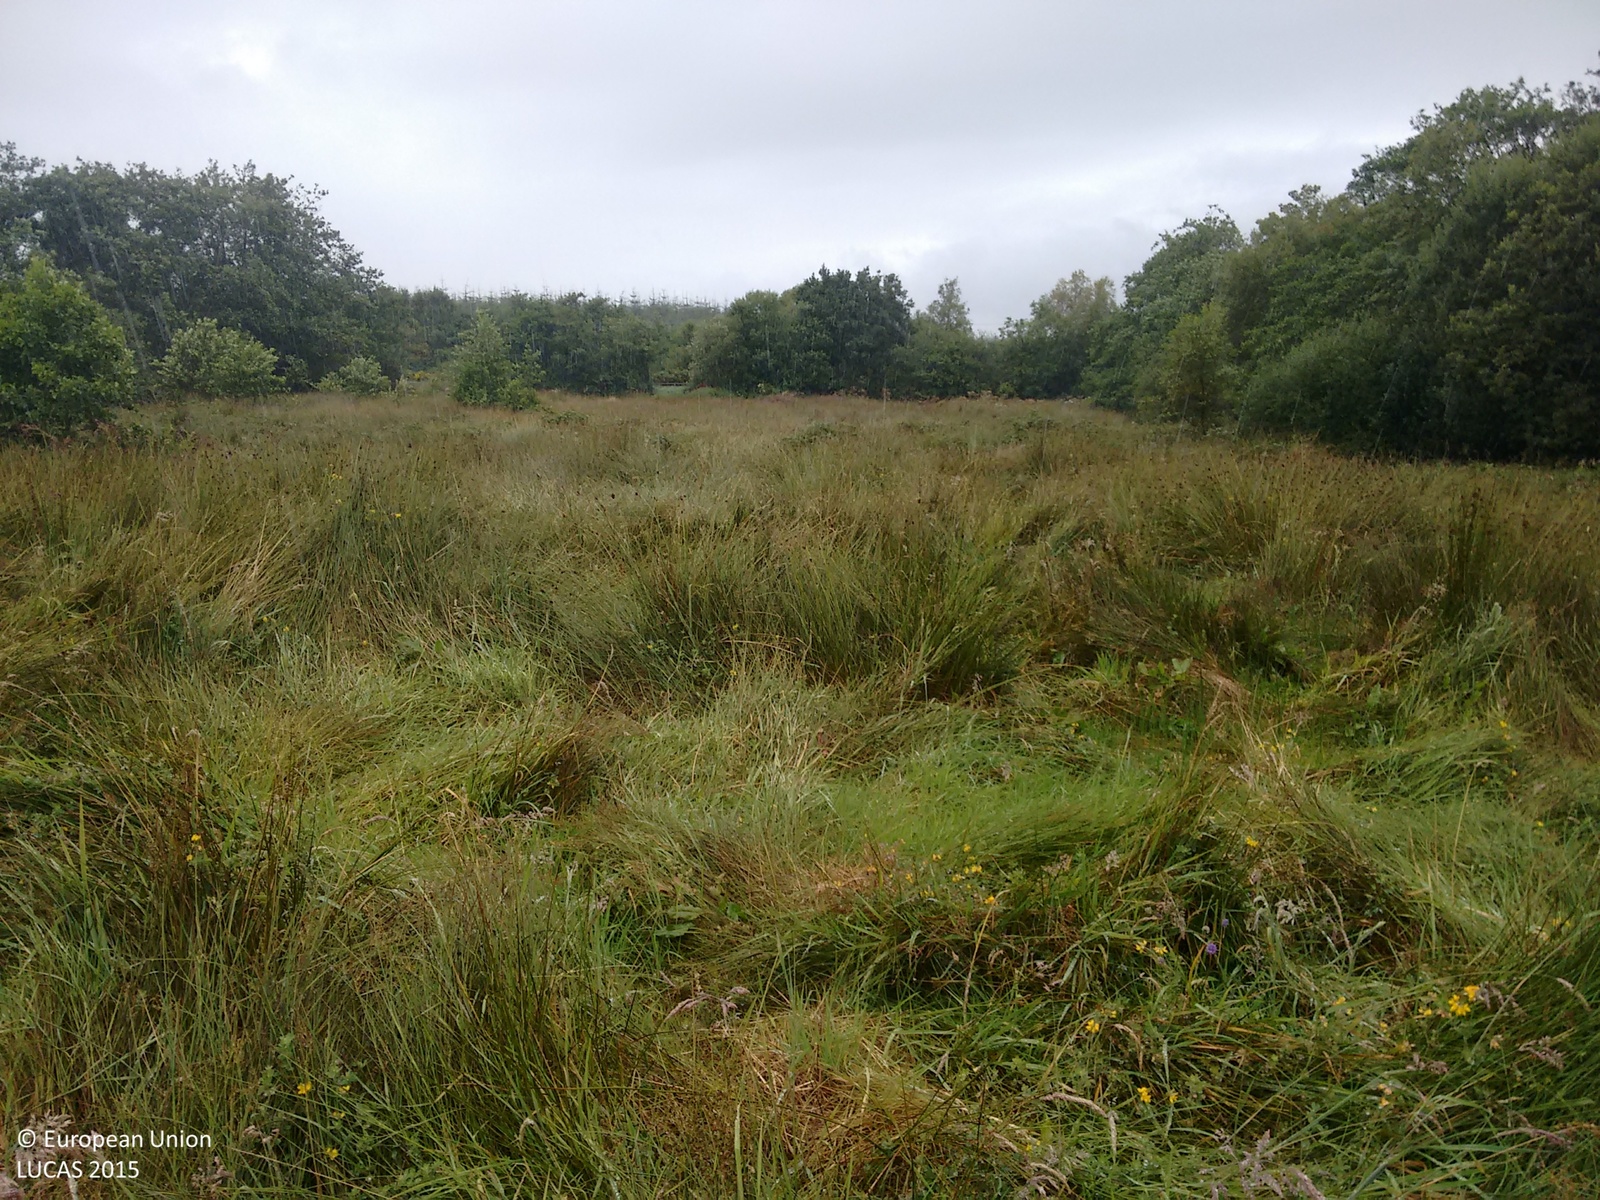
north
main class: Grassland
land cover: Grassland with sparse tree/shrub cover
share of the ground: > 75 %
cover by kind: herbaceous plants 95 %, broadleaved forest trees 5 %
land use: Abandoned areas
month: September
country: IE
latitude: 52.0591
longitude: -9.3478
